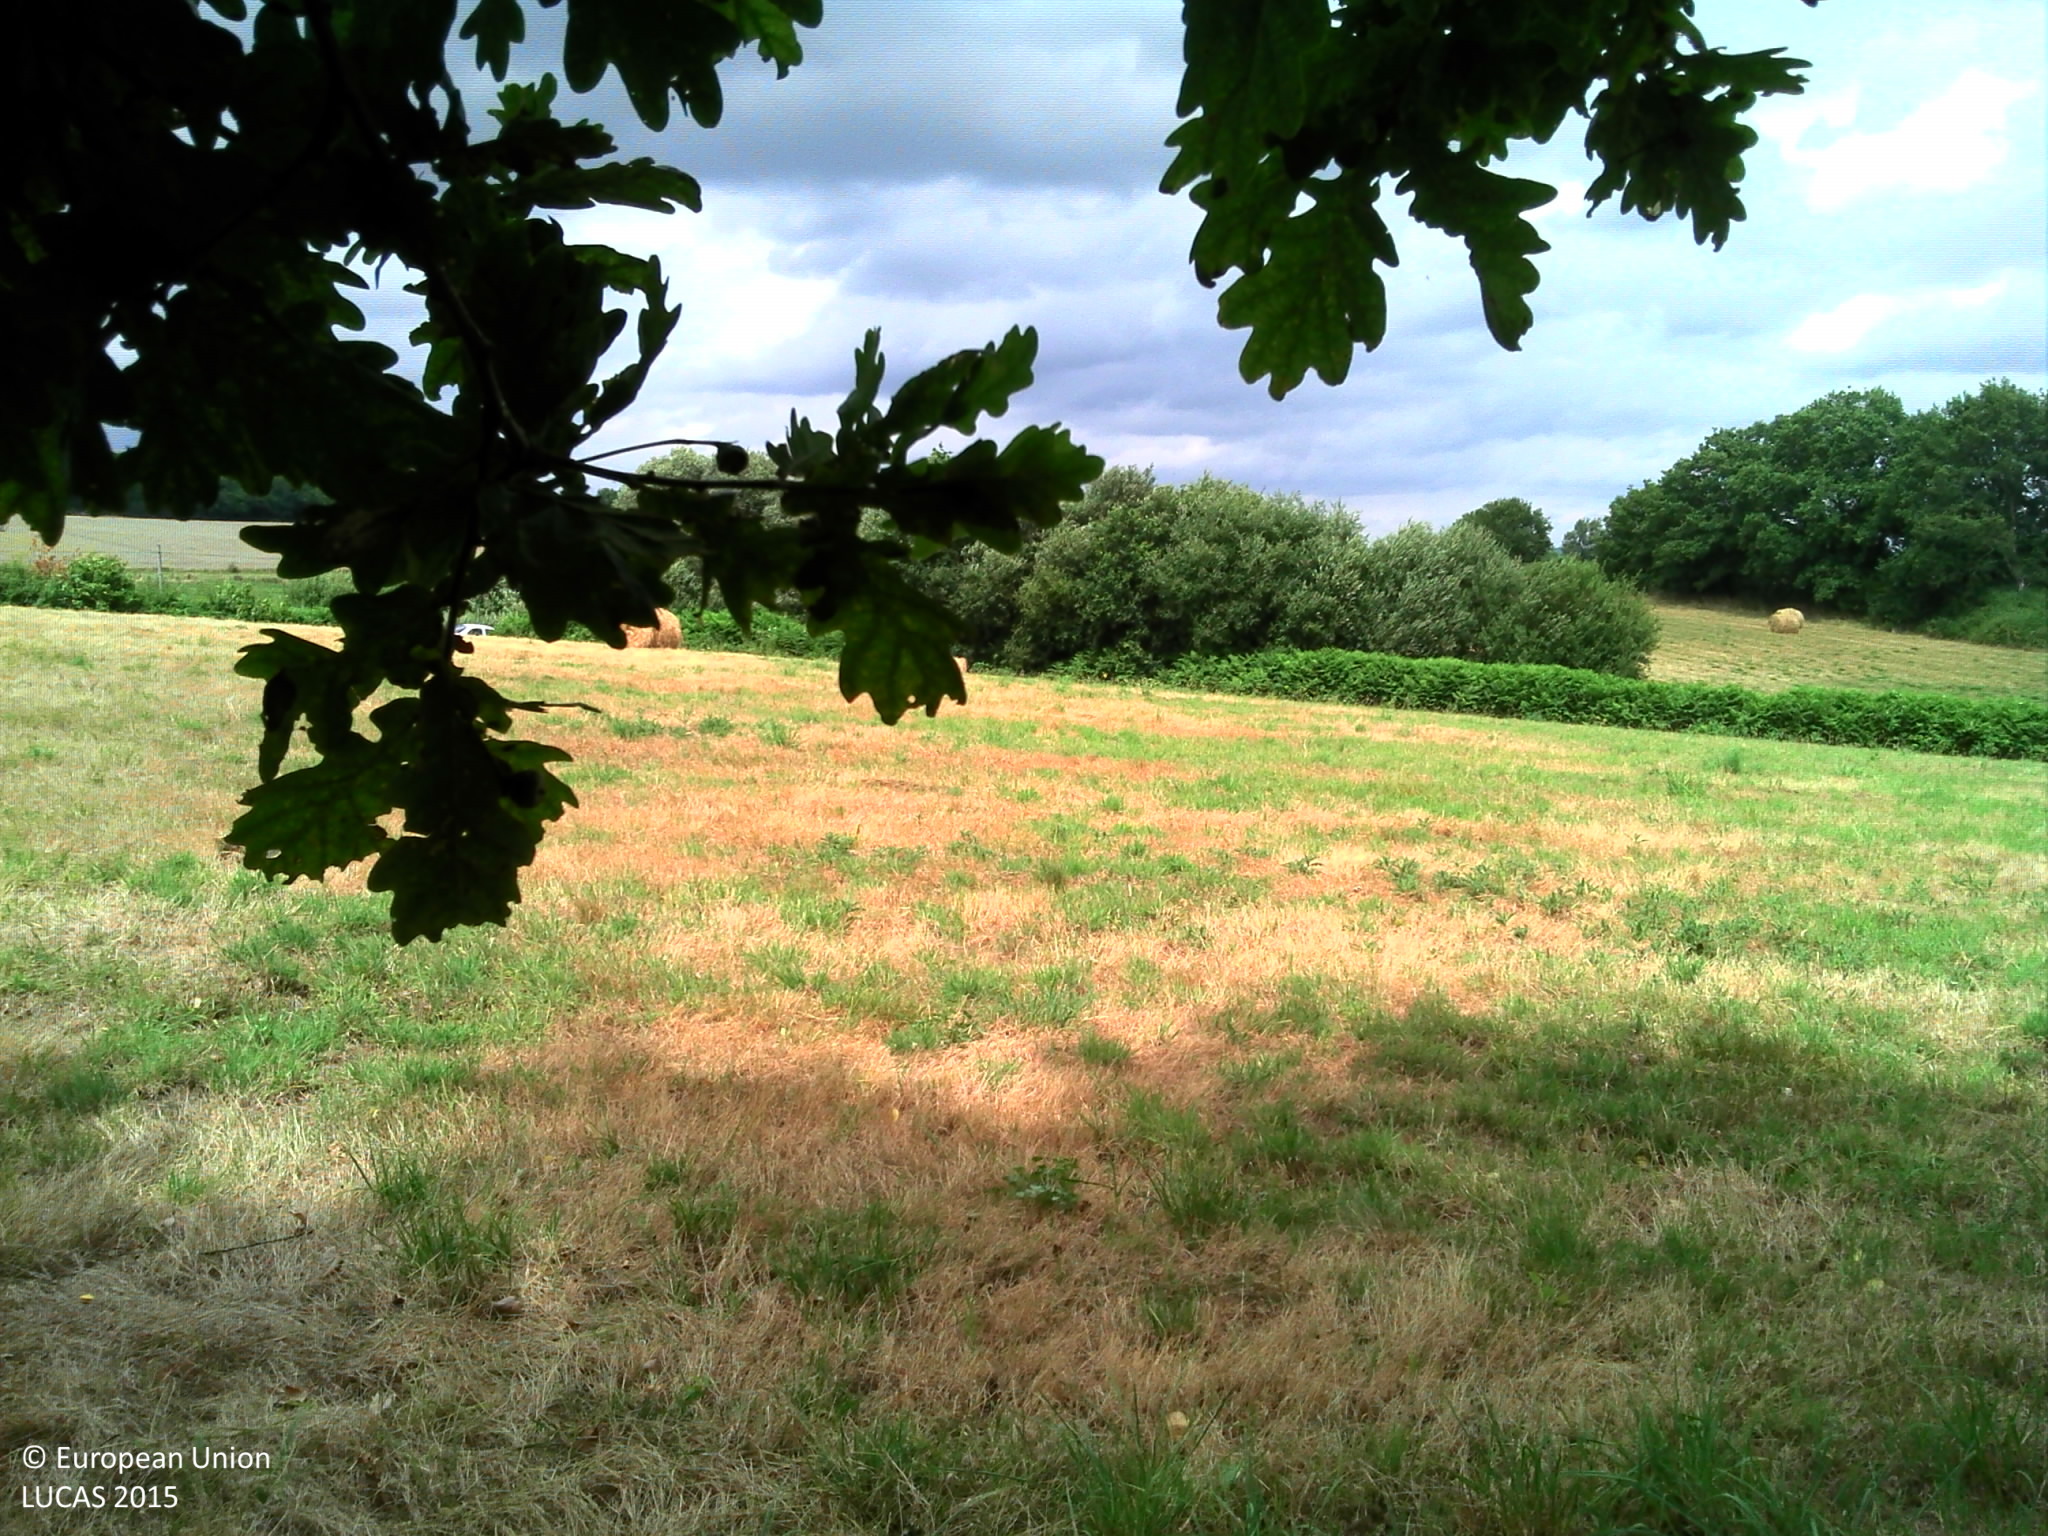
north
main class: Woodland
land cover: Broadleaved woodland
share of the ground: > 75 %
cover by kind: broadleaved forest trees 80 %, herbaceous plants 20 %
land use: Semi-natural and natural areas not in use
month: July
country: FR
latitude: 48.3963
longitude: -0.0650
